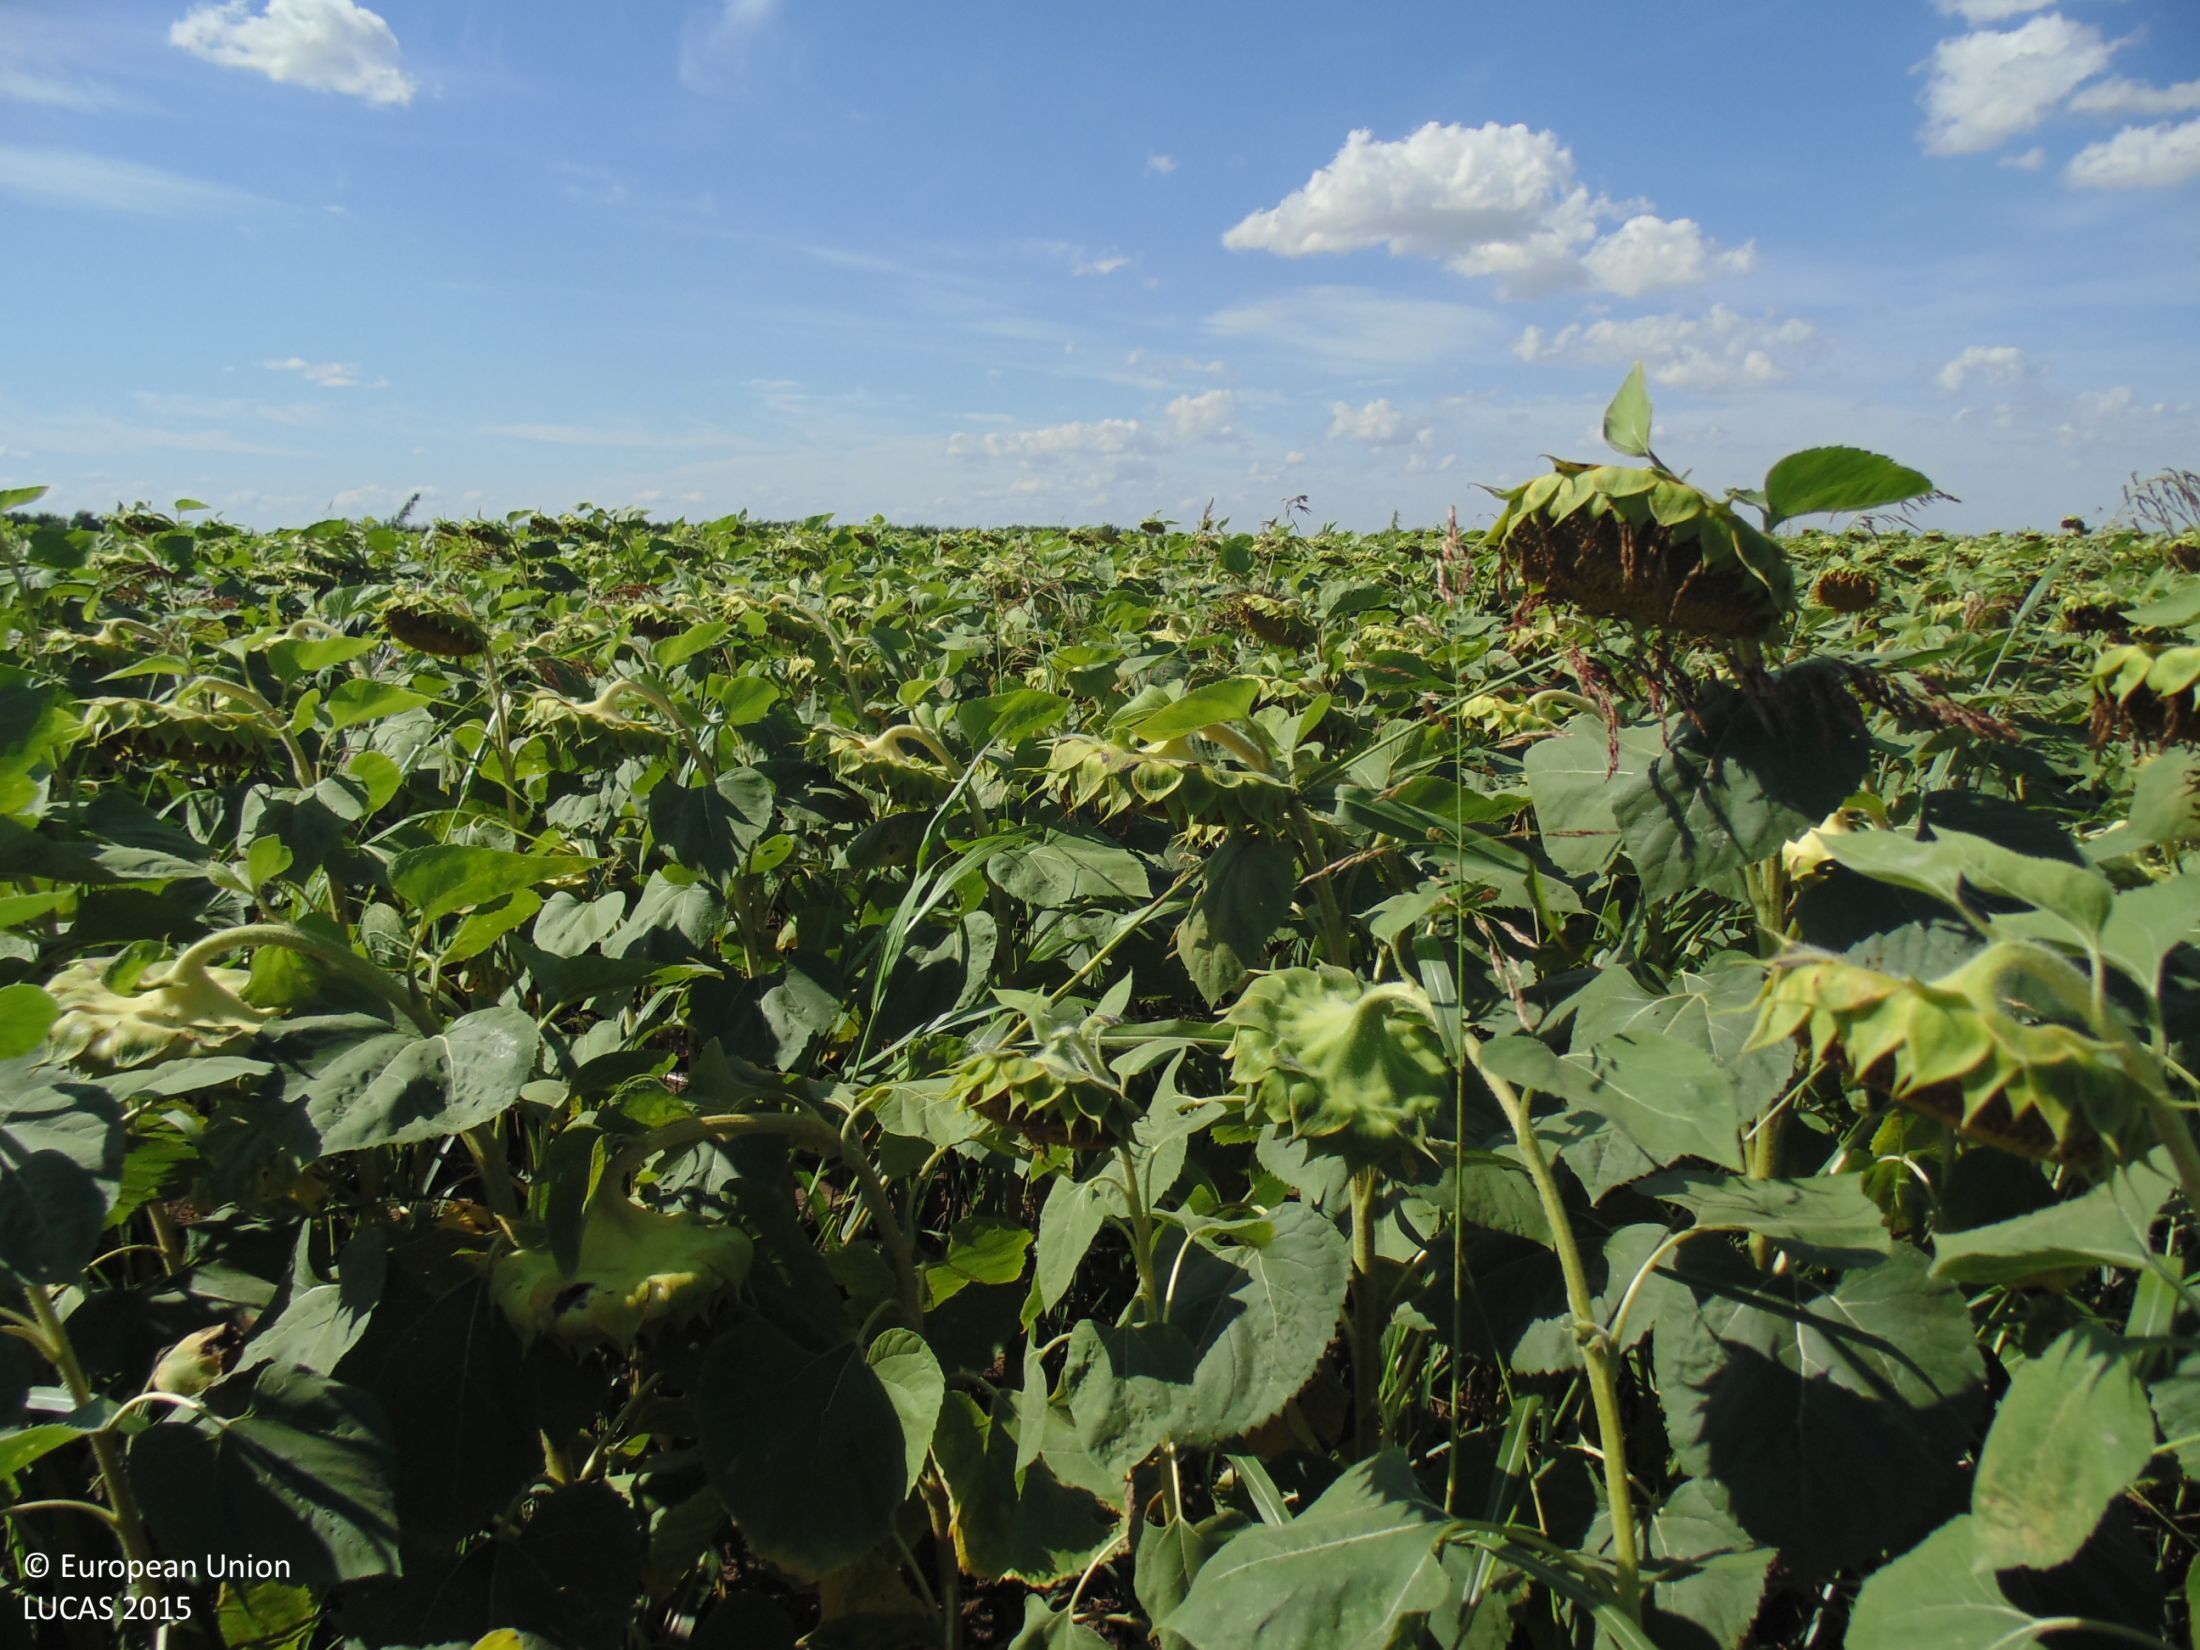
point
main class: Cropland
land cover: Sunflower
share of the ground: > 75 %
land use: Agriculture (excluding fallow land and kitchen gardens)
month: August
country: BG
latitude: 43.7437
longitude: 27.8645
